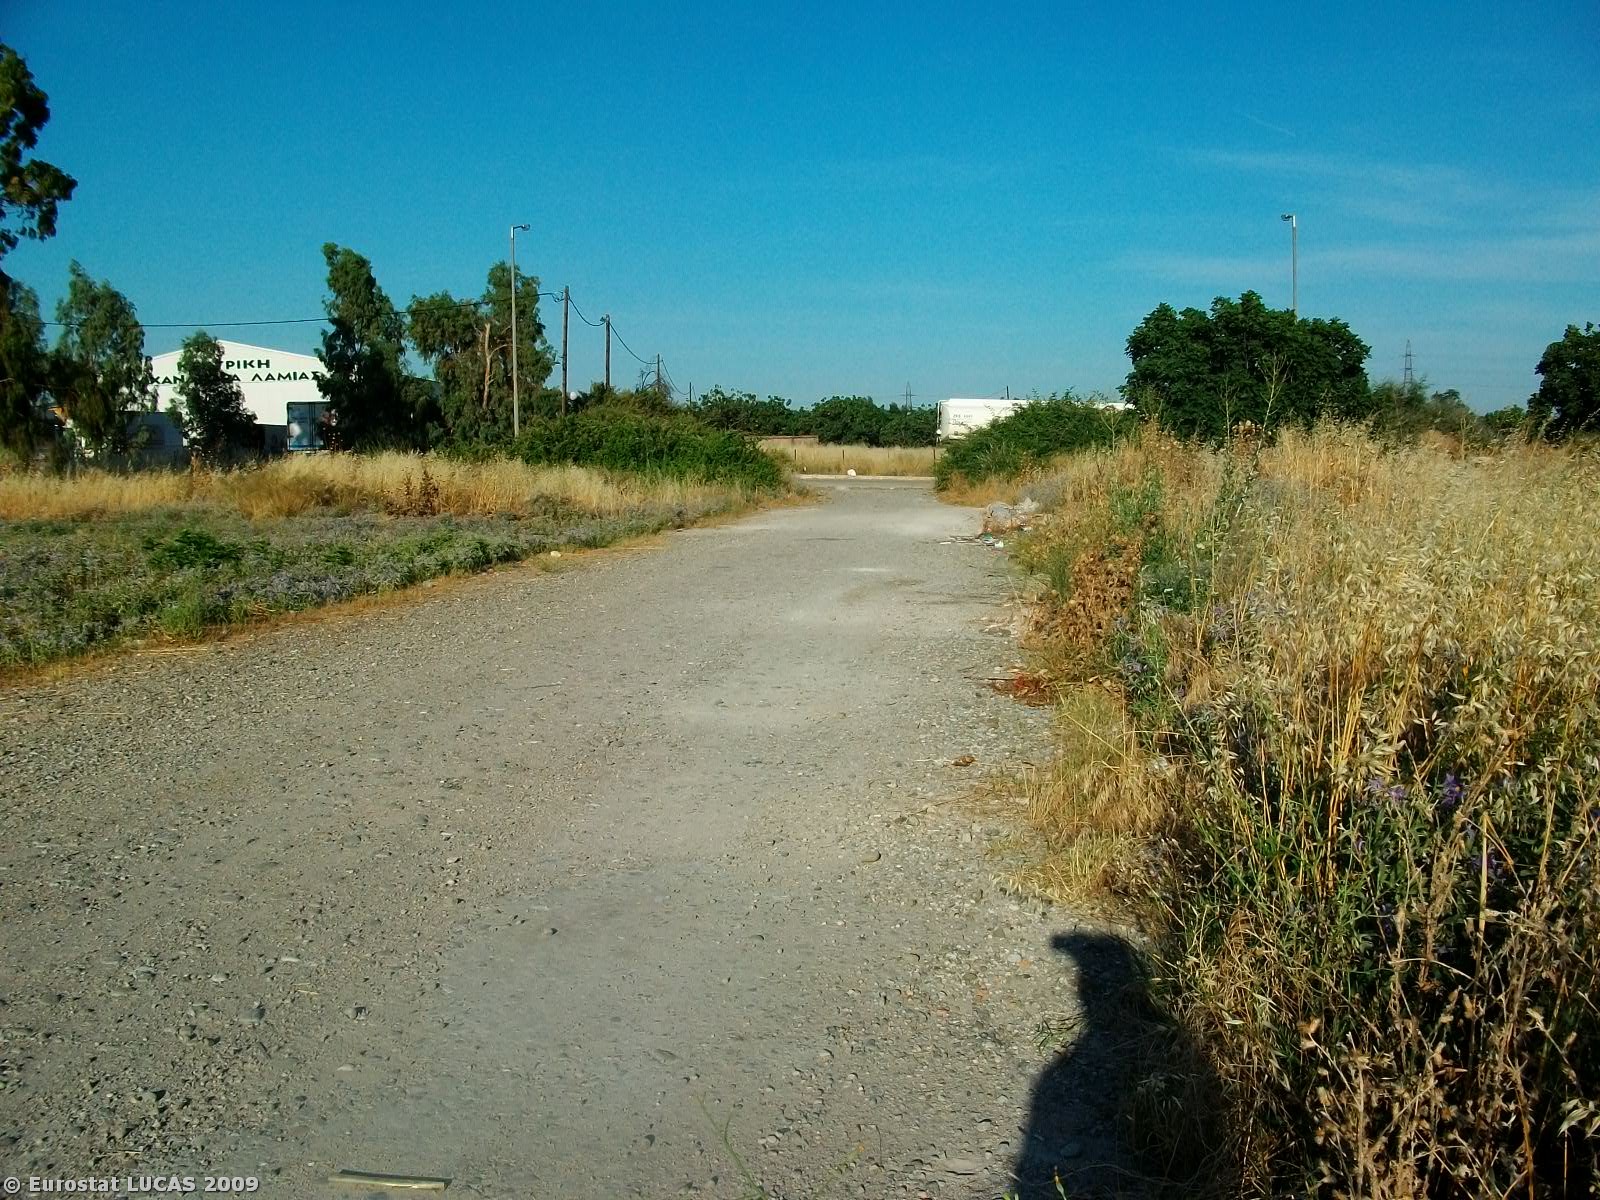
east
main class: Grassland
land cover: Grassland without tree/shrub cover
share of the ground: > 75 %
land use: Unused
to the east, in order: Grassland without tree/shrub cover; Fences; Single bushes/trees; Paved roads, cycling and walking lanes; Shruby margins; Fences; Grassland without tree/shrub cover; Olive groves
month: June
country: GR
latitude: 38.8865
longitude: 22.4427
